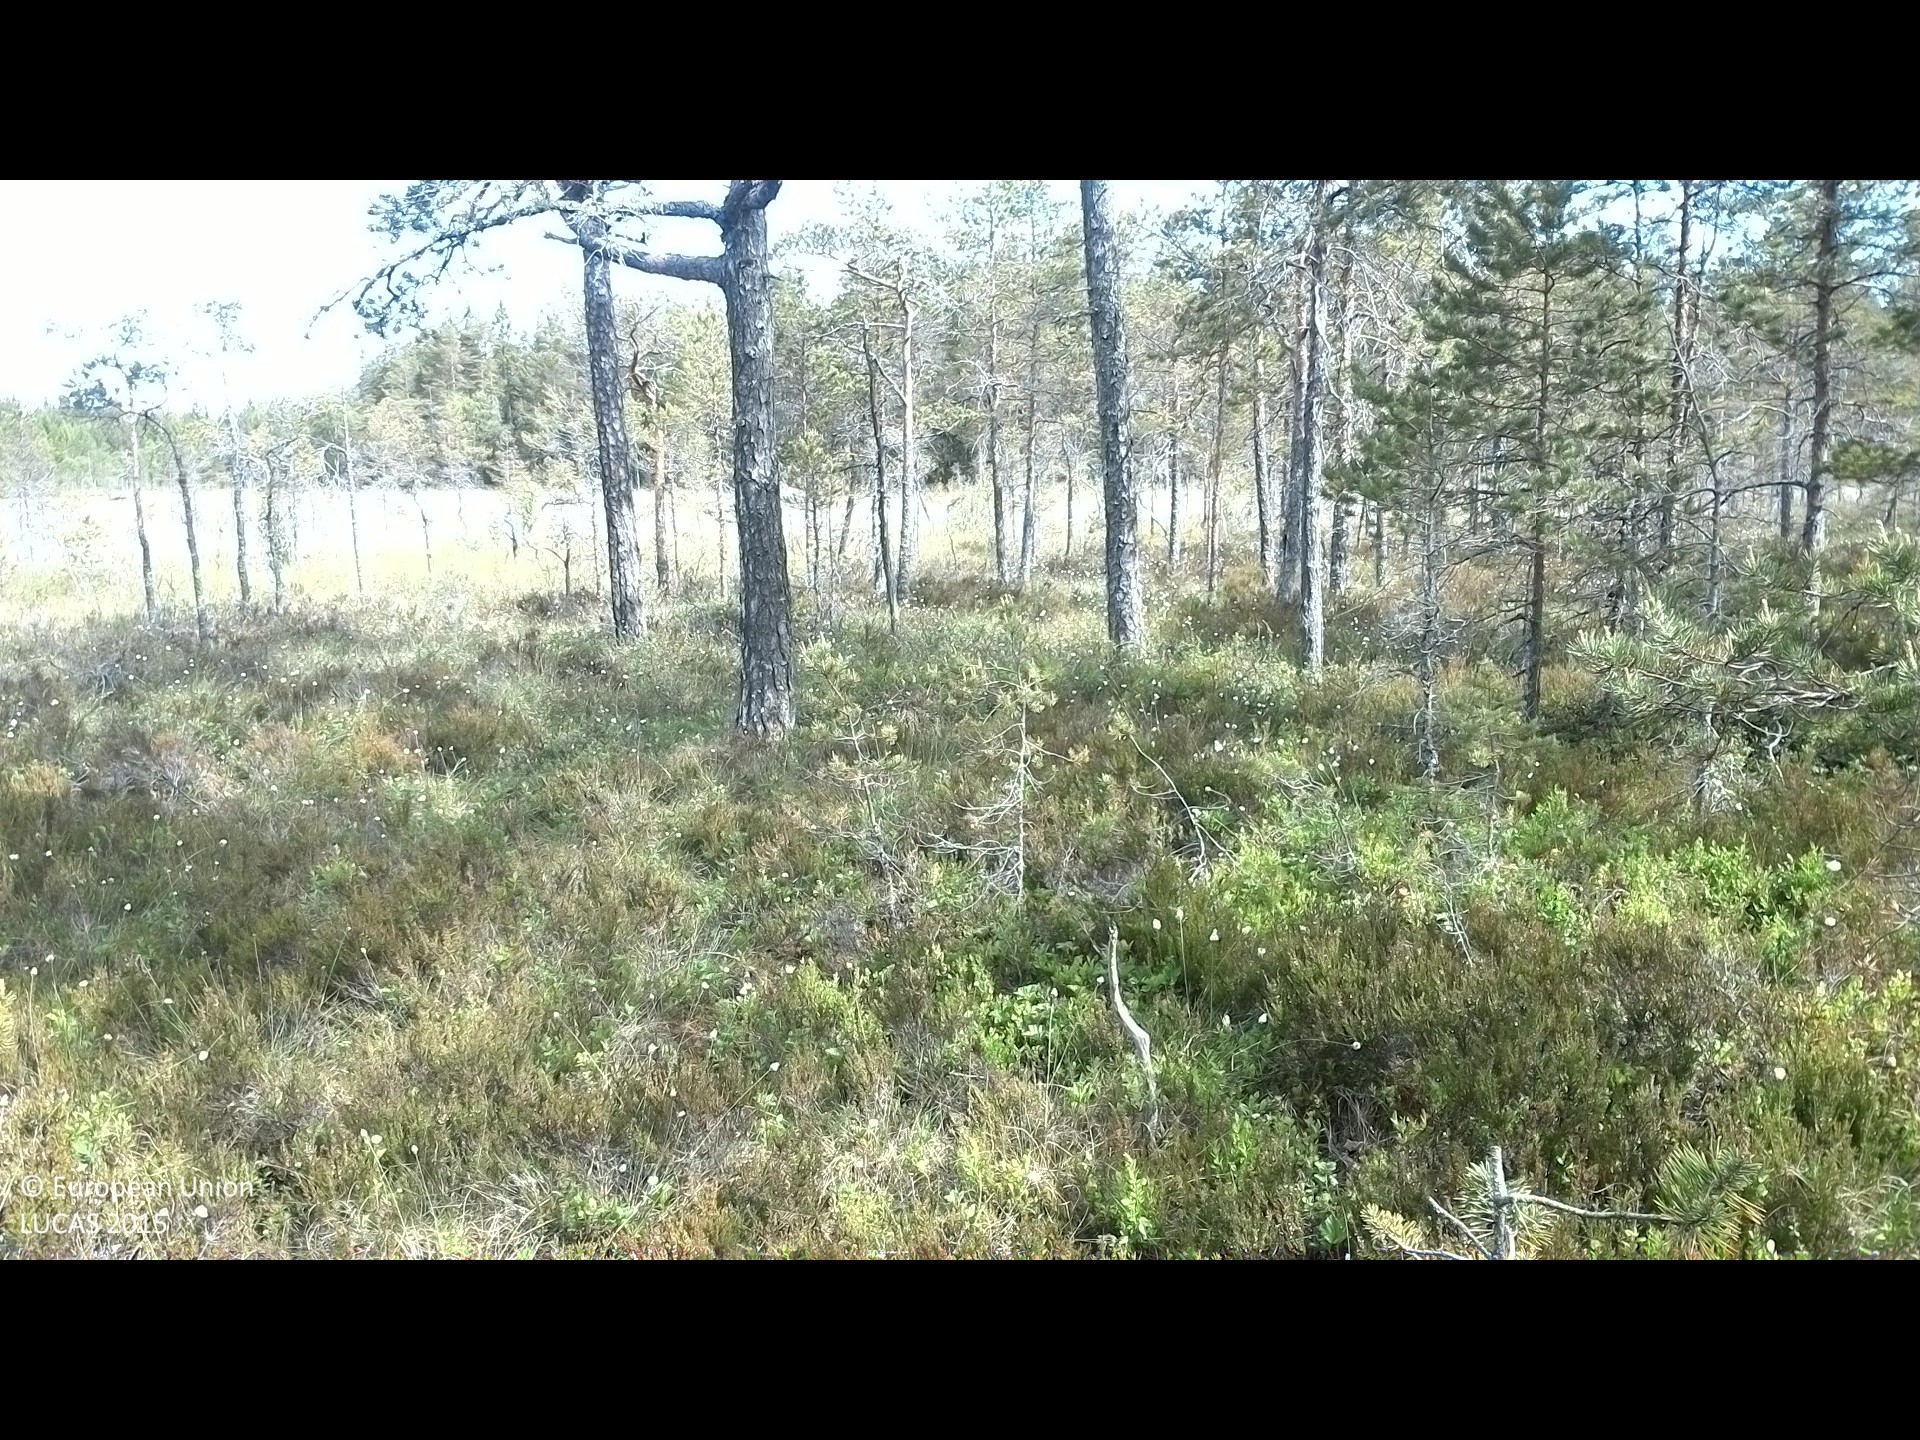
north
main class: Woodland
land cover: Pine dominated coniferous woodland
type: mire and swamp forests
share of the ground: 10 - 25 %
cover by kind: herbaceous plants 35 %, coniferous forest trees 25 %, shrubs 25 %, lichens and mosses 15 %
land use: Forestry
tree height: > 5 m
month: June
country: SE
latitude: 62.2399
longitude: 17.5837
